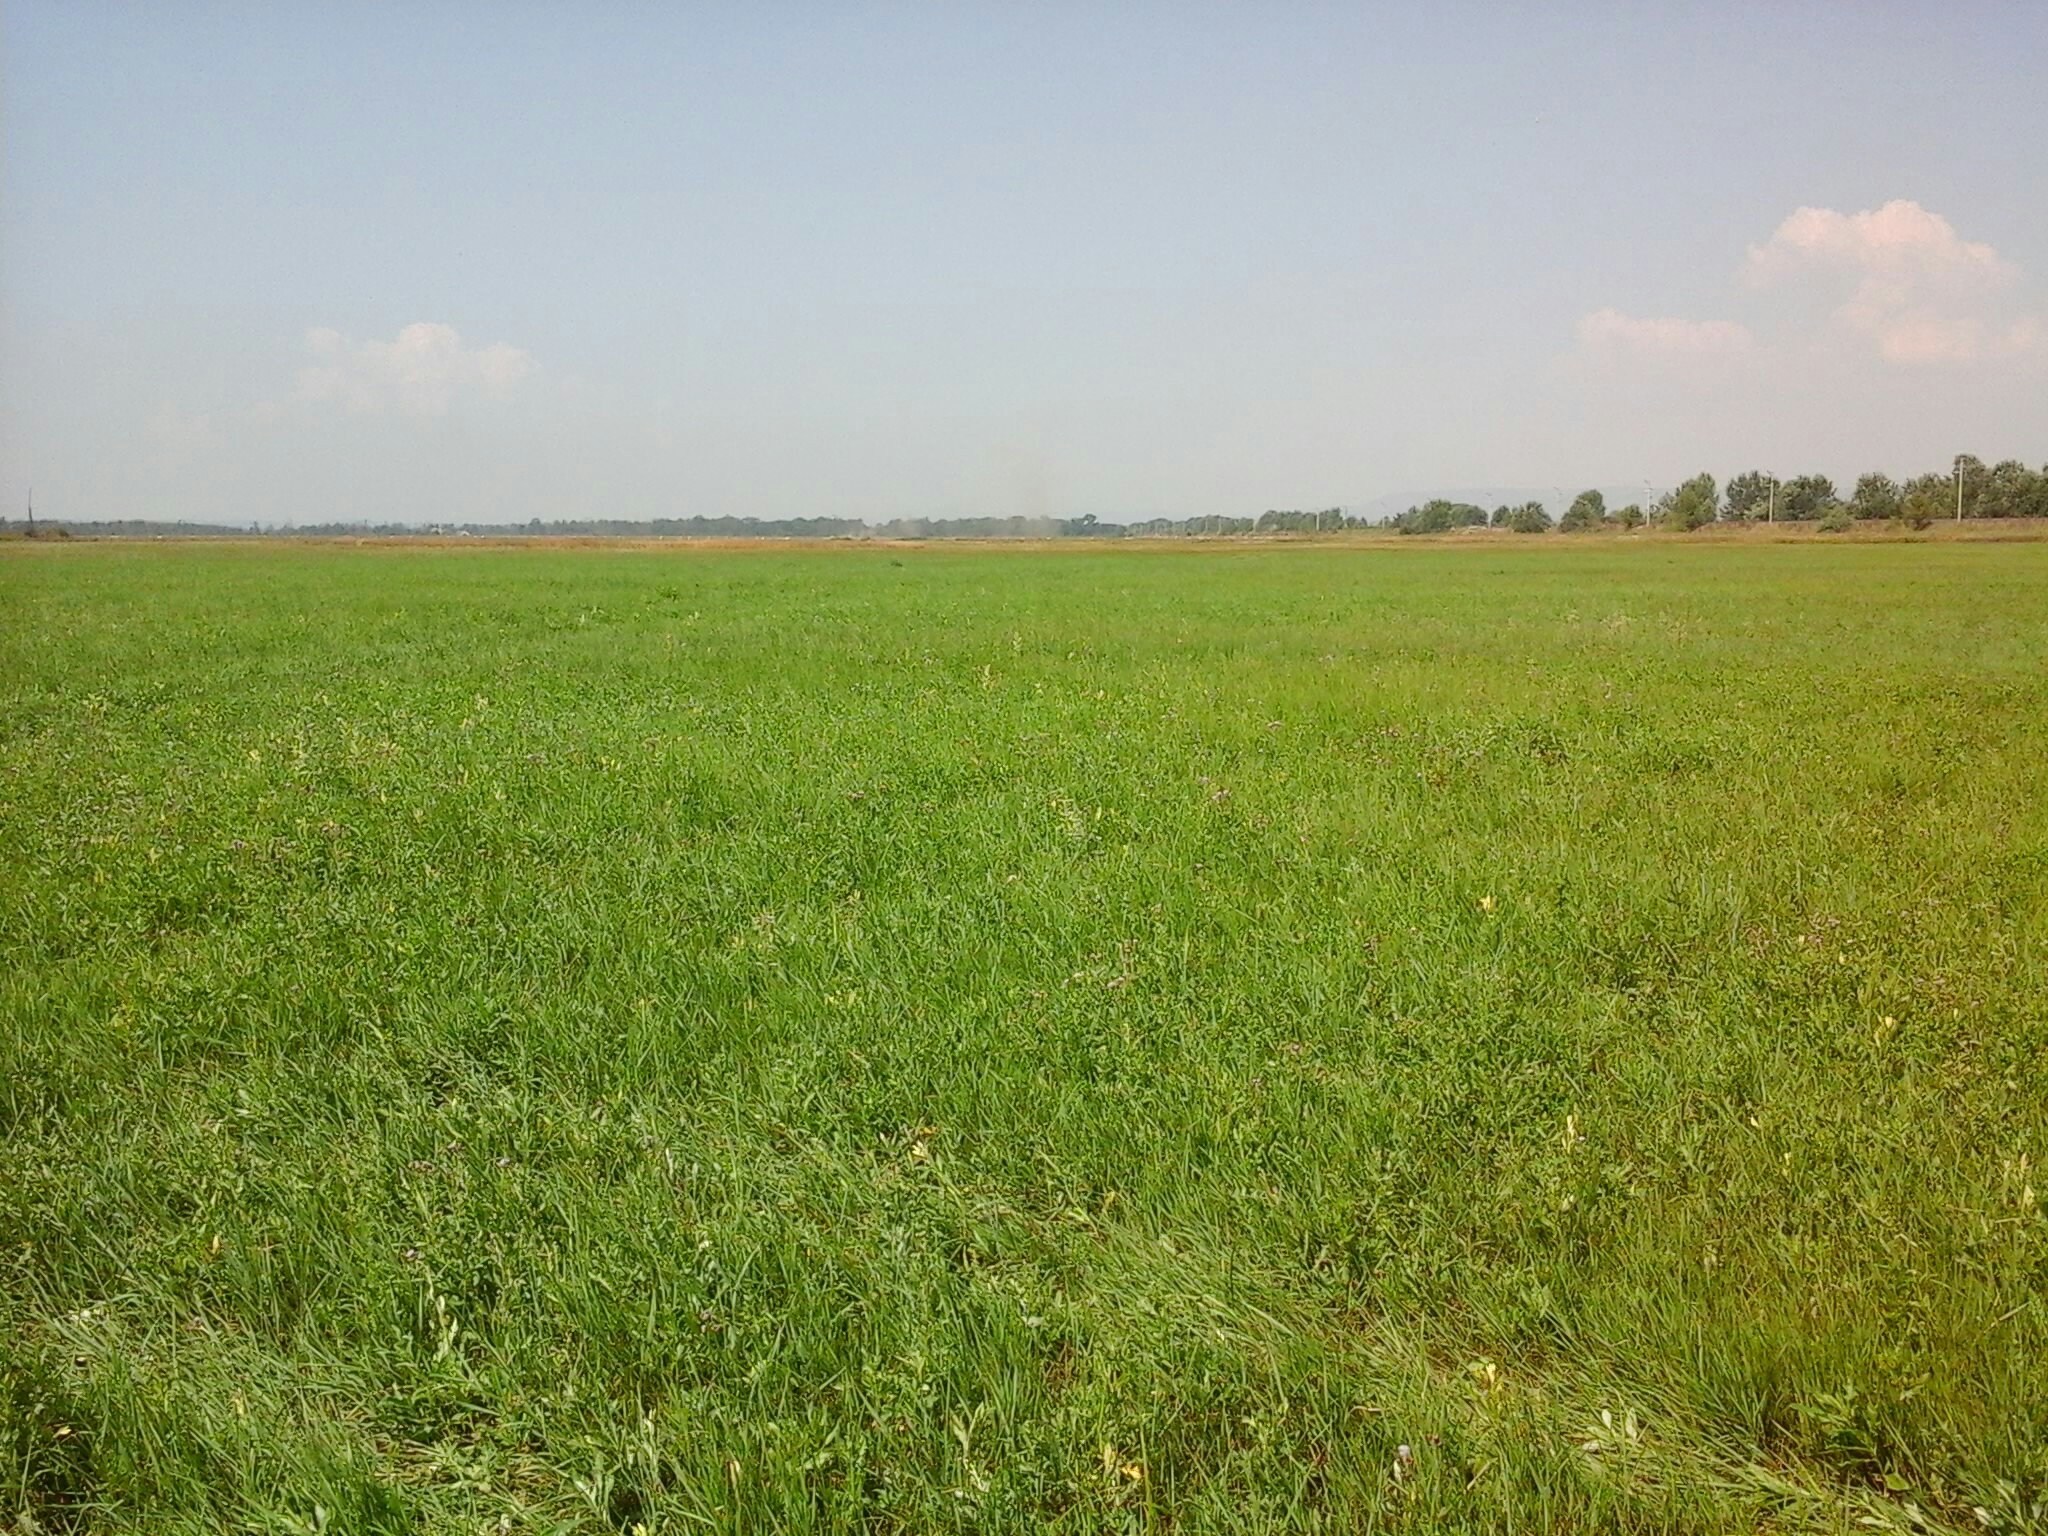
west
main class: Grassland
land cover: Grassland without tree/shrub cover
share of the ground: > 75 %
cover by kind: herbaceous plants 100 %
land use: Agriculture (excluding fallow land and kitchen gardens)
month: August
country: HU
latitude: 47.1697
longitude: 18.2833
